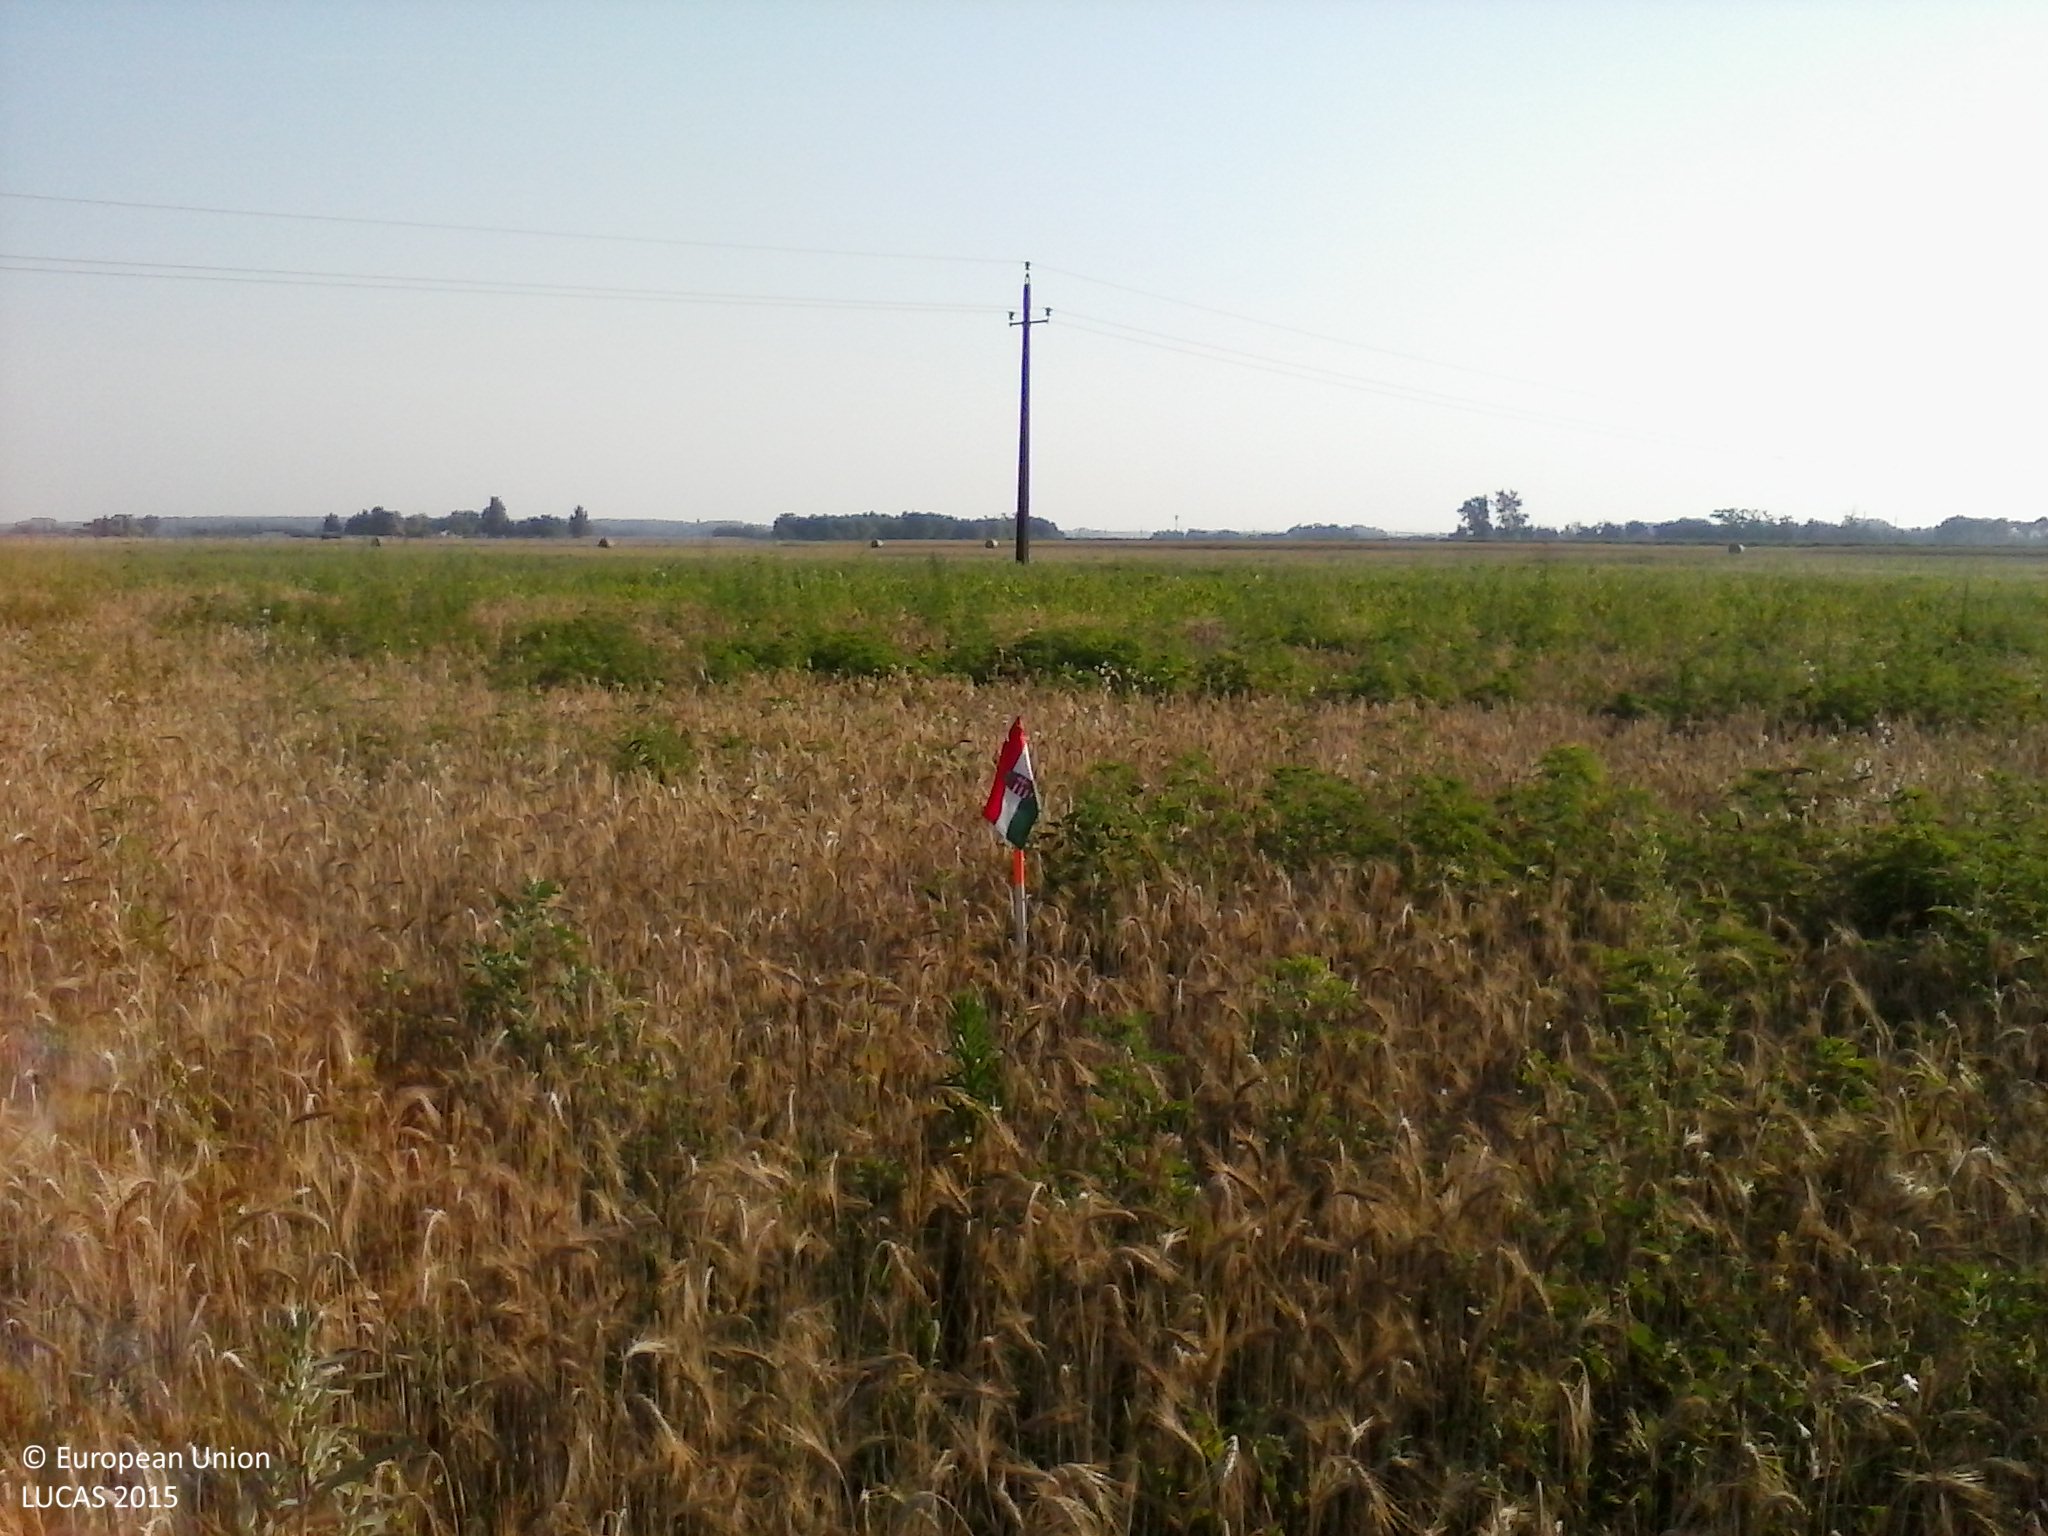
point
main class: Cropland
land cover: Common wheat
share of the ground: > 75 %
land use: Agriculture (excluding fallow land and kitchen gardens)
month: July
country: HU
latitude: 46.4456
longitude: 19.5856
